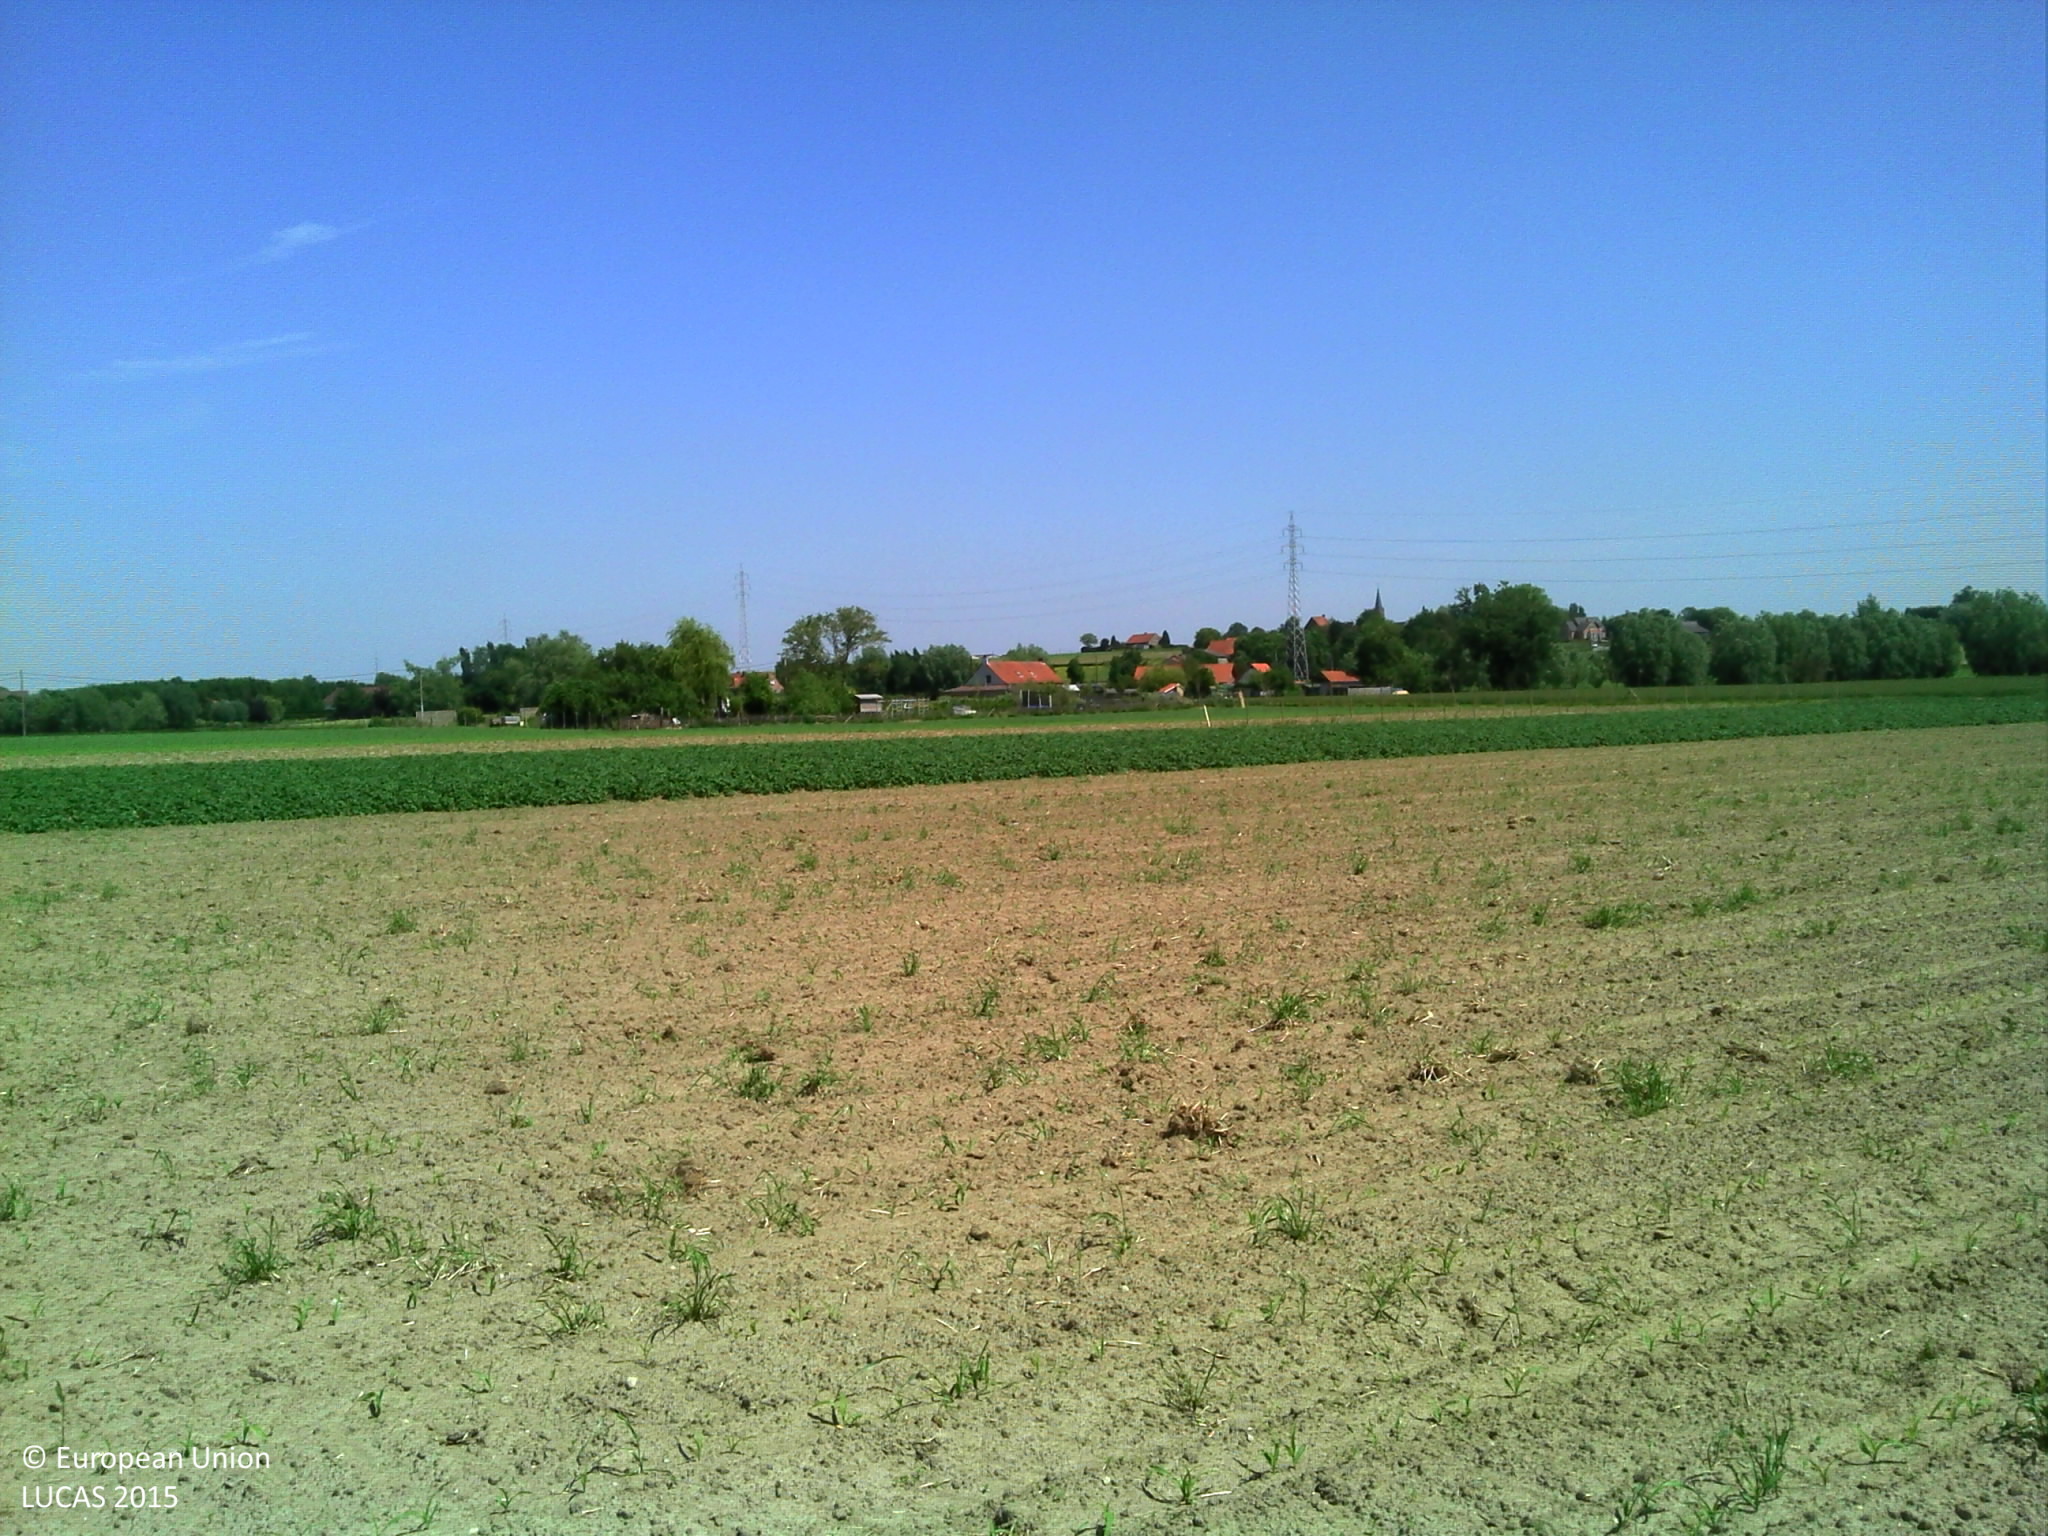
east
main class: Cropland
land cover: Maize
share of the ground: 10 - 25 %
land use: Agriculture (excluding fallow land and kitchen gardens)
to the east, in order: Maize; Potatoes; Grass margins; Lines of trees; Other bare soil; Temporary grasslands; Artificial constructions in urban areas
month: June
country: BE
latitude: 50.8151
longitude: 2.9641
